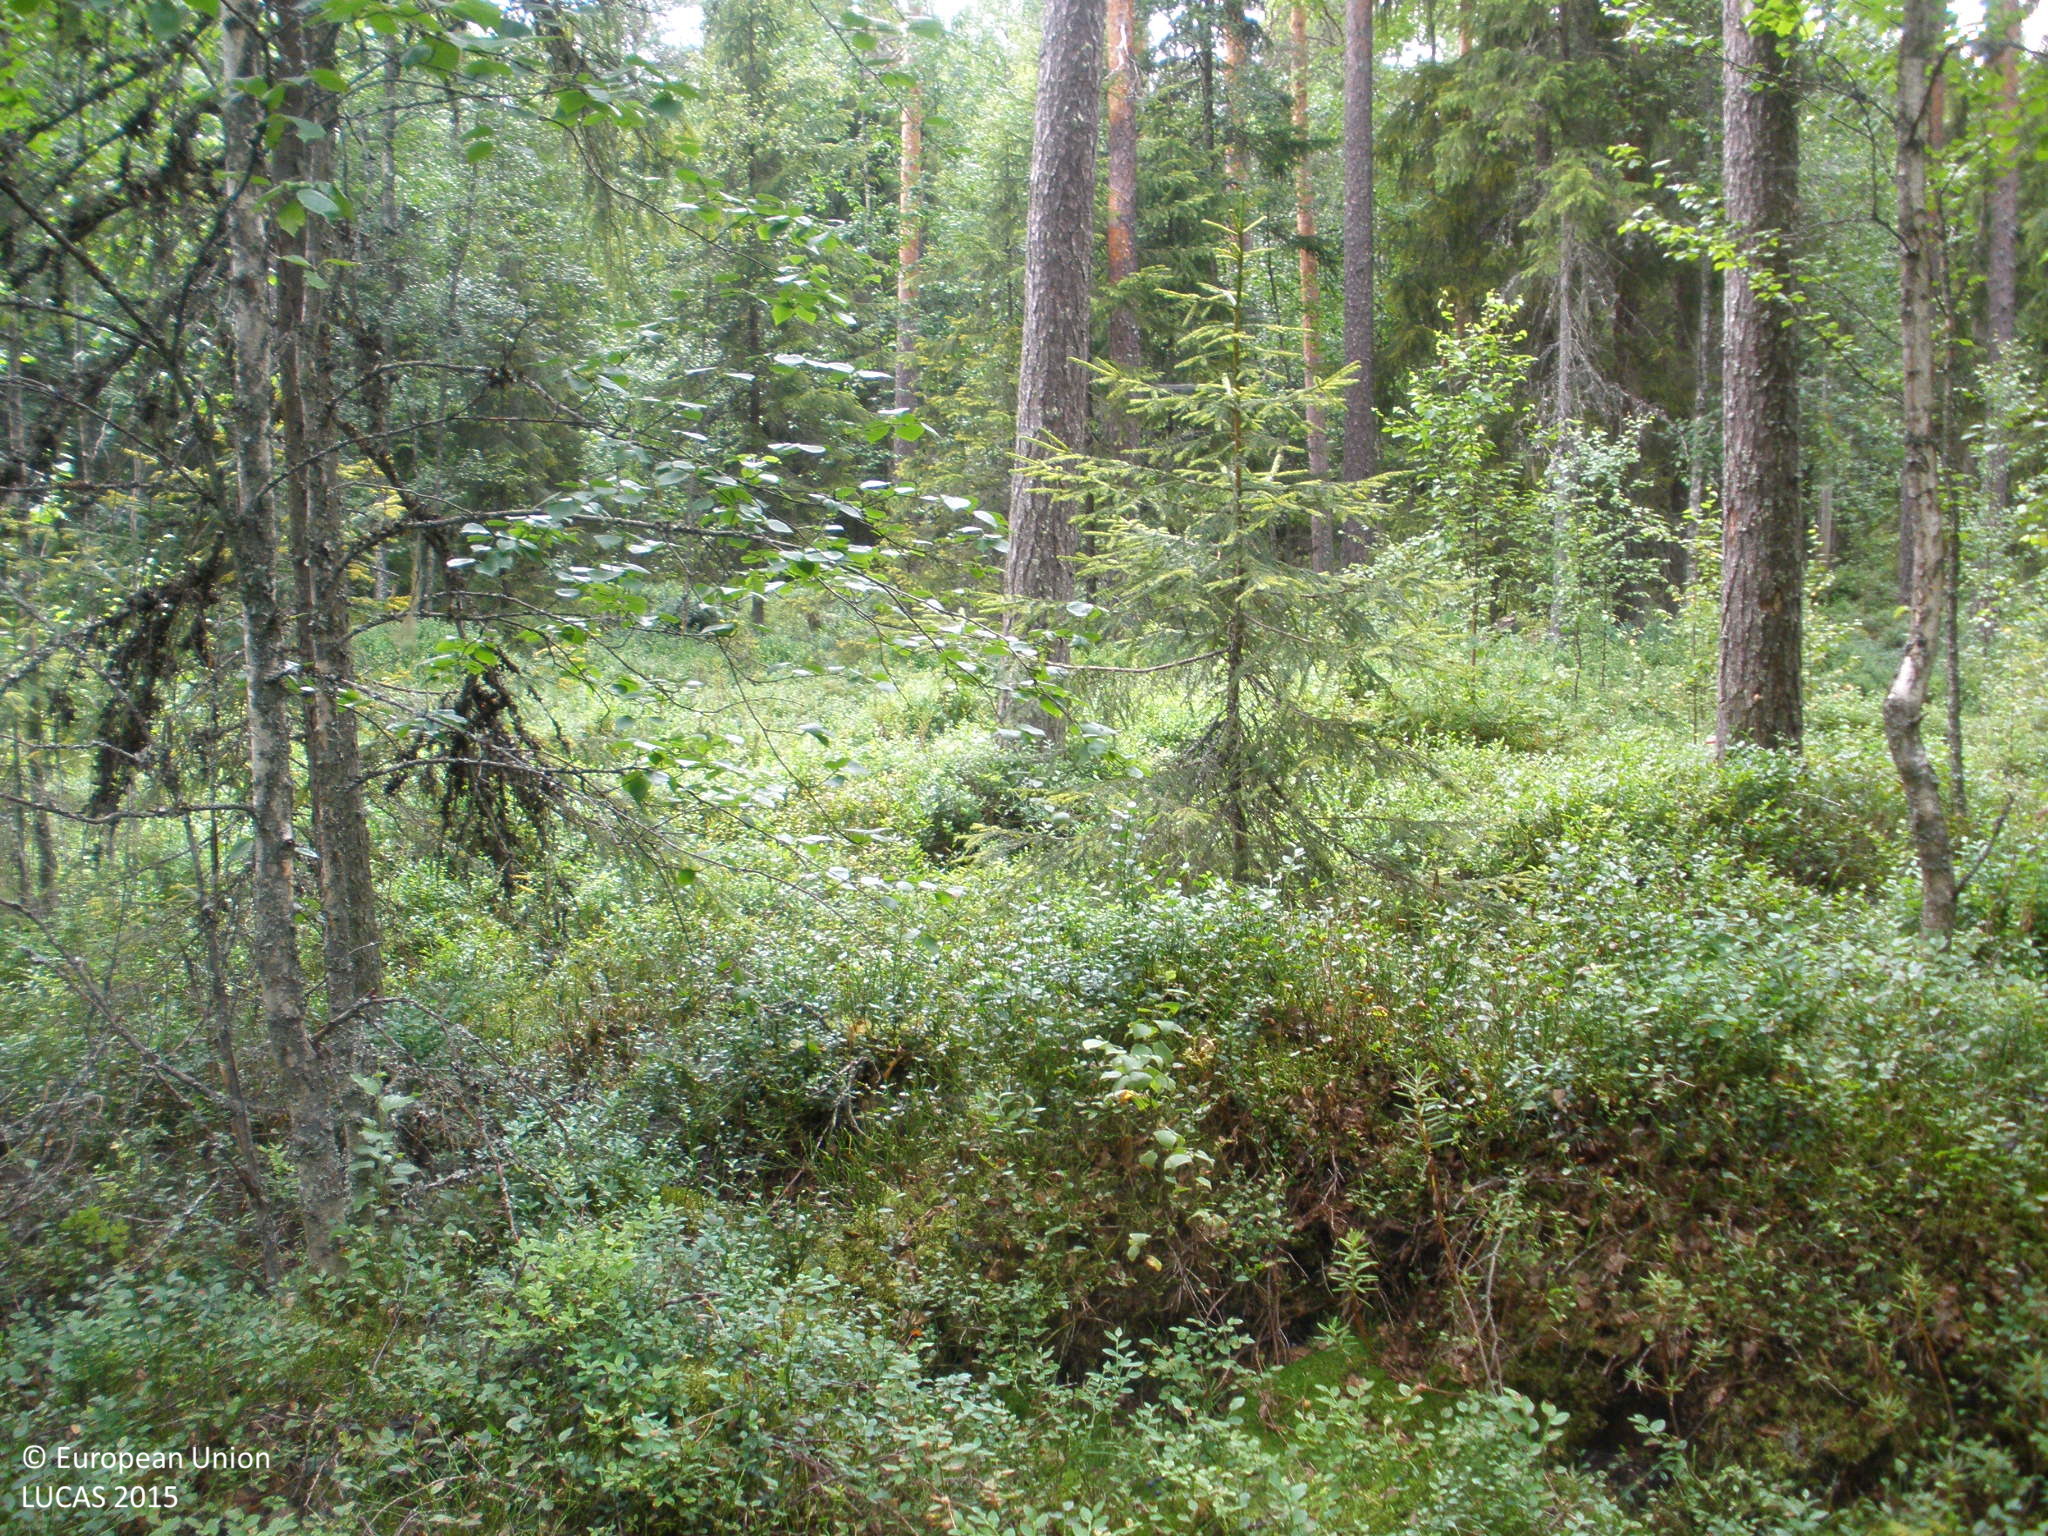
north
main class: Woodland
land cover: Pine dominated mixed woodland
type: boreal forest
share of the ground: > 75 %
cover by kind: coniferous forest trees 60 %, broadleaved forest trees 25 %, lichens and mosses 10 %, herbaceous plants 5 %
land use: Forestry
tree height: > 5 m
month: July
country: FI
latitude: 61.1676
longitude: 25.2302
